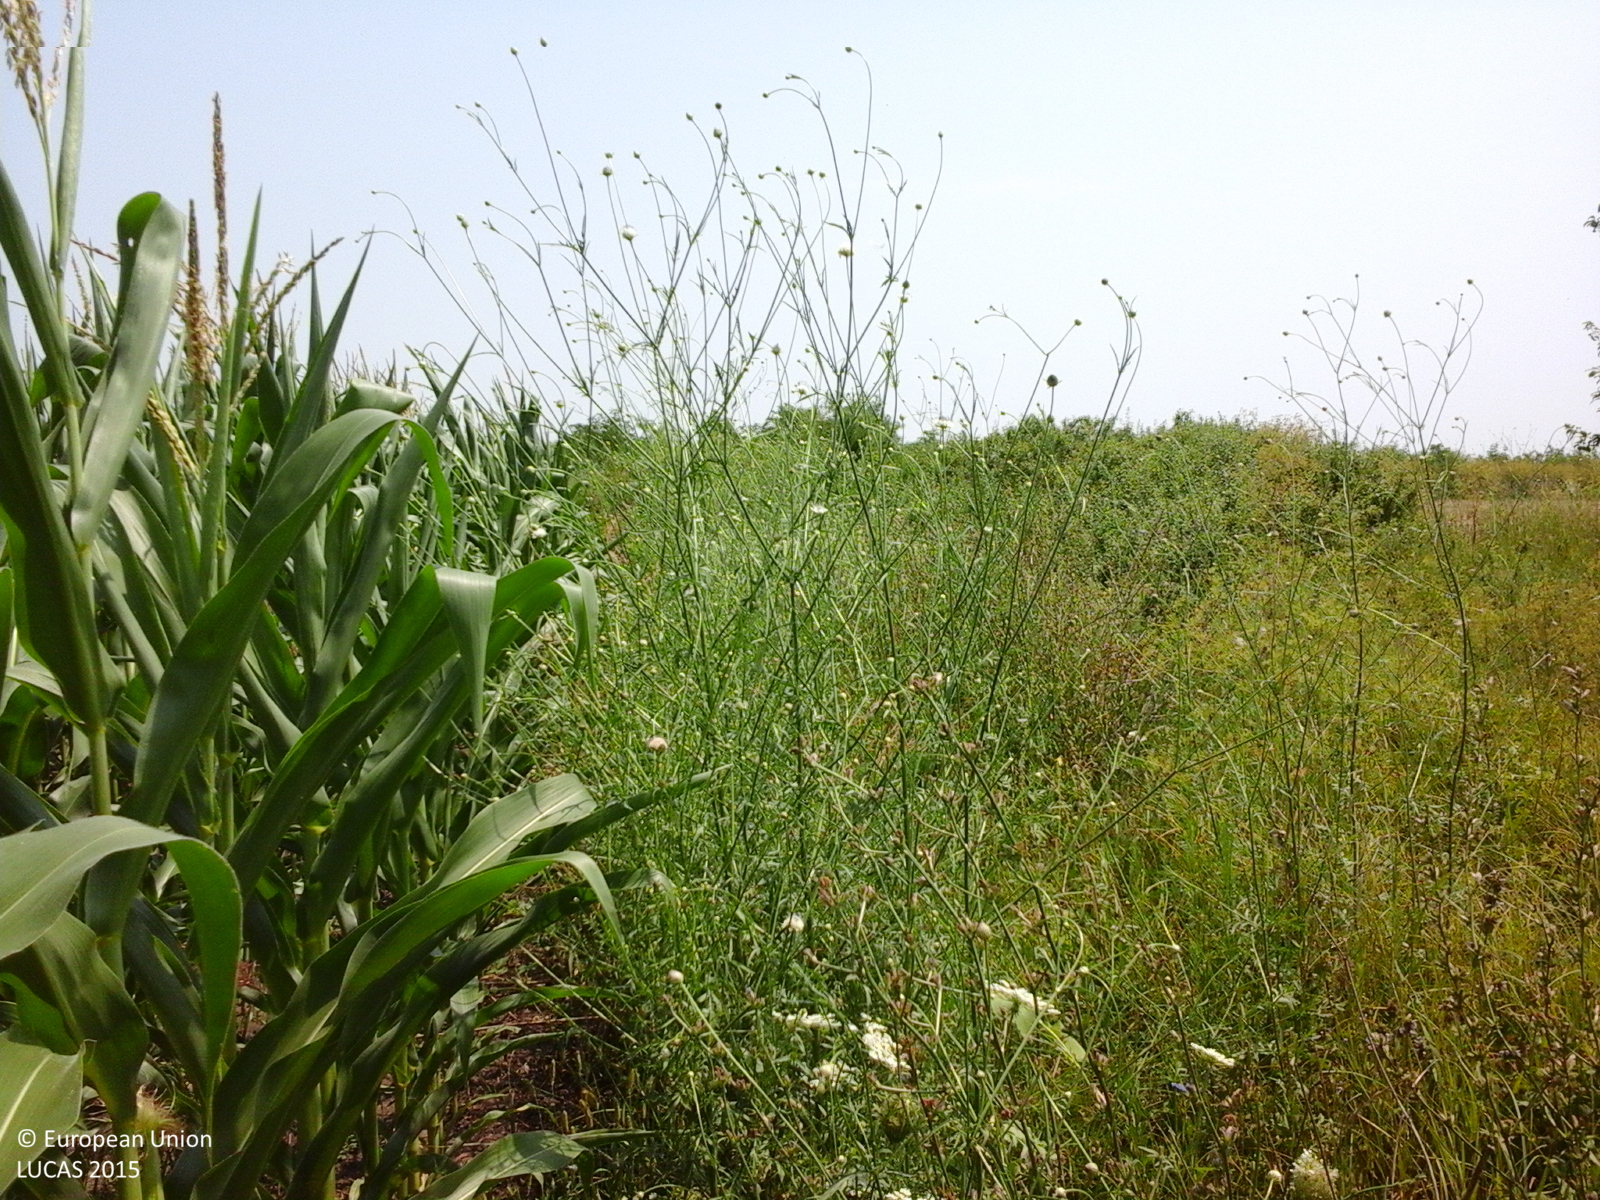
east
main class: Cropland
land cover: Maize
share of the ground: > 75 %
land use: Agriculture (excluding fallow land and kitchen gardens)
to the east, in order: Maize; Abandoned hedges; Ditches and canals; Abandoned hedges; Tracks; Arable land (only in case pi)
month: July
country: RO
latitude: 44.7640
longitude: 26.2717
